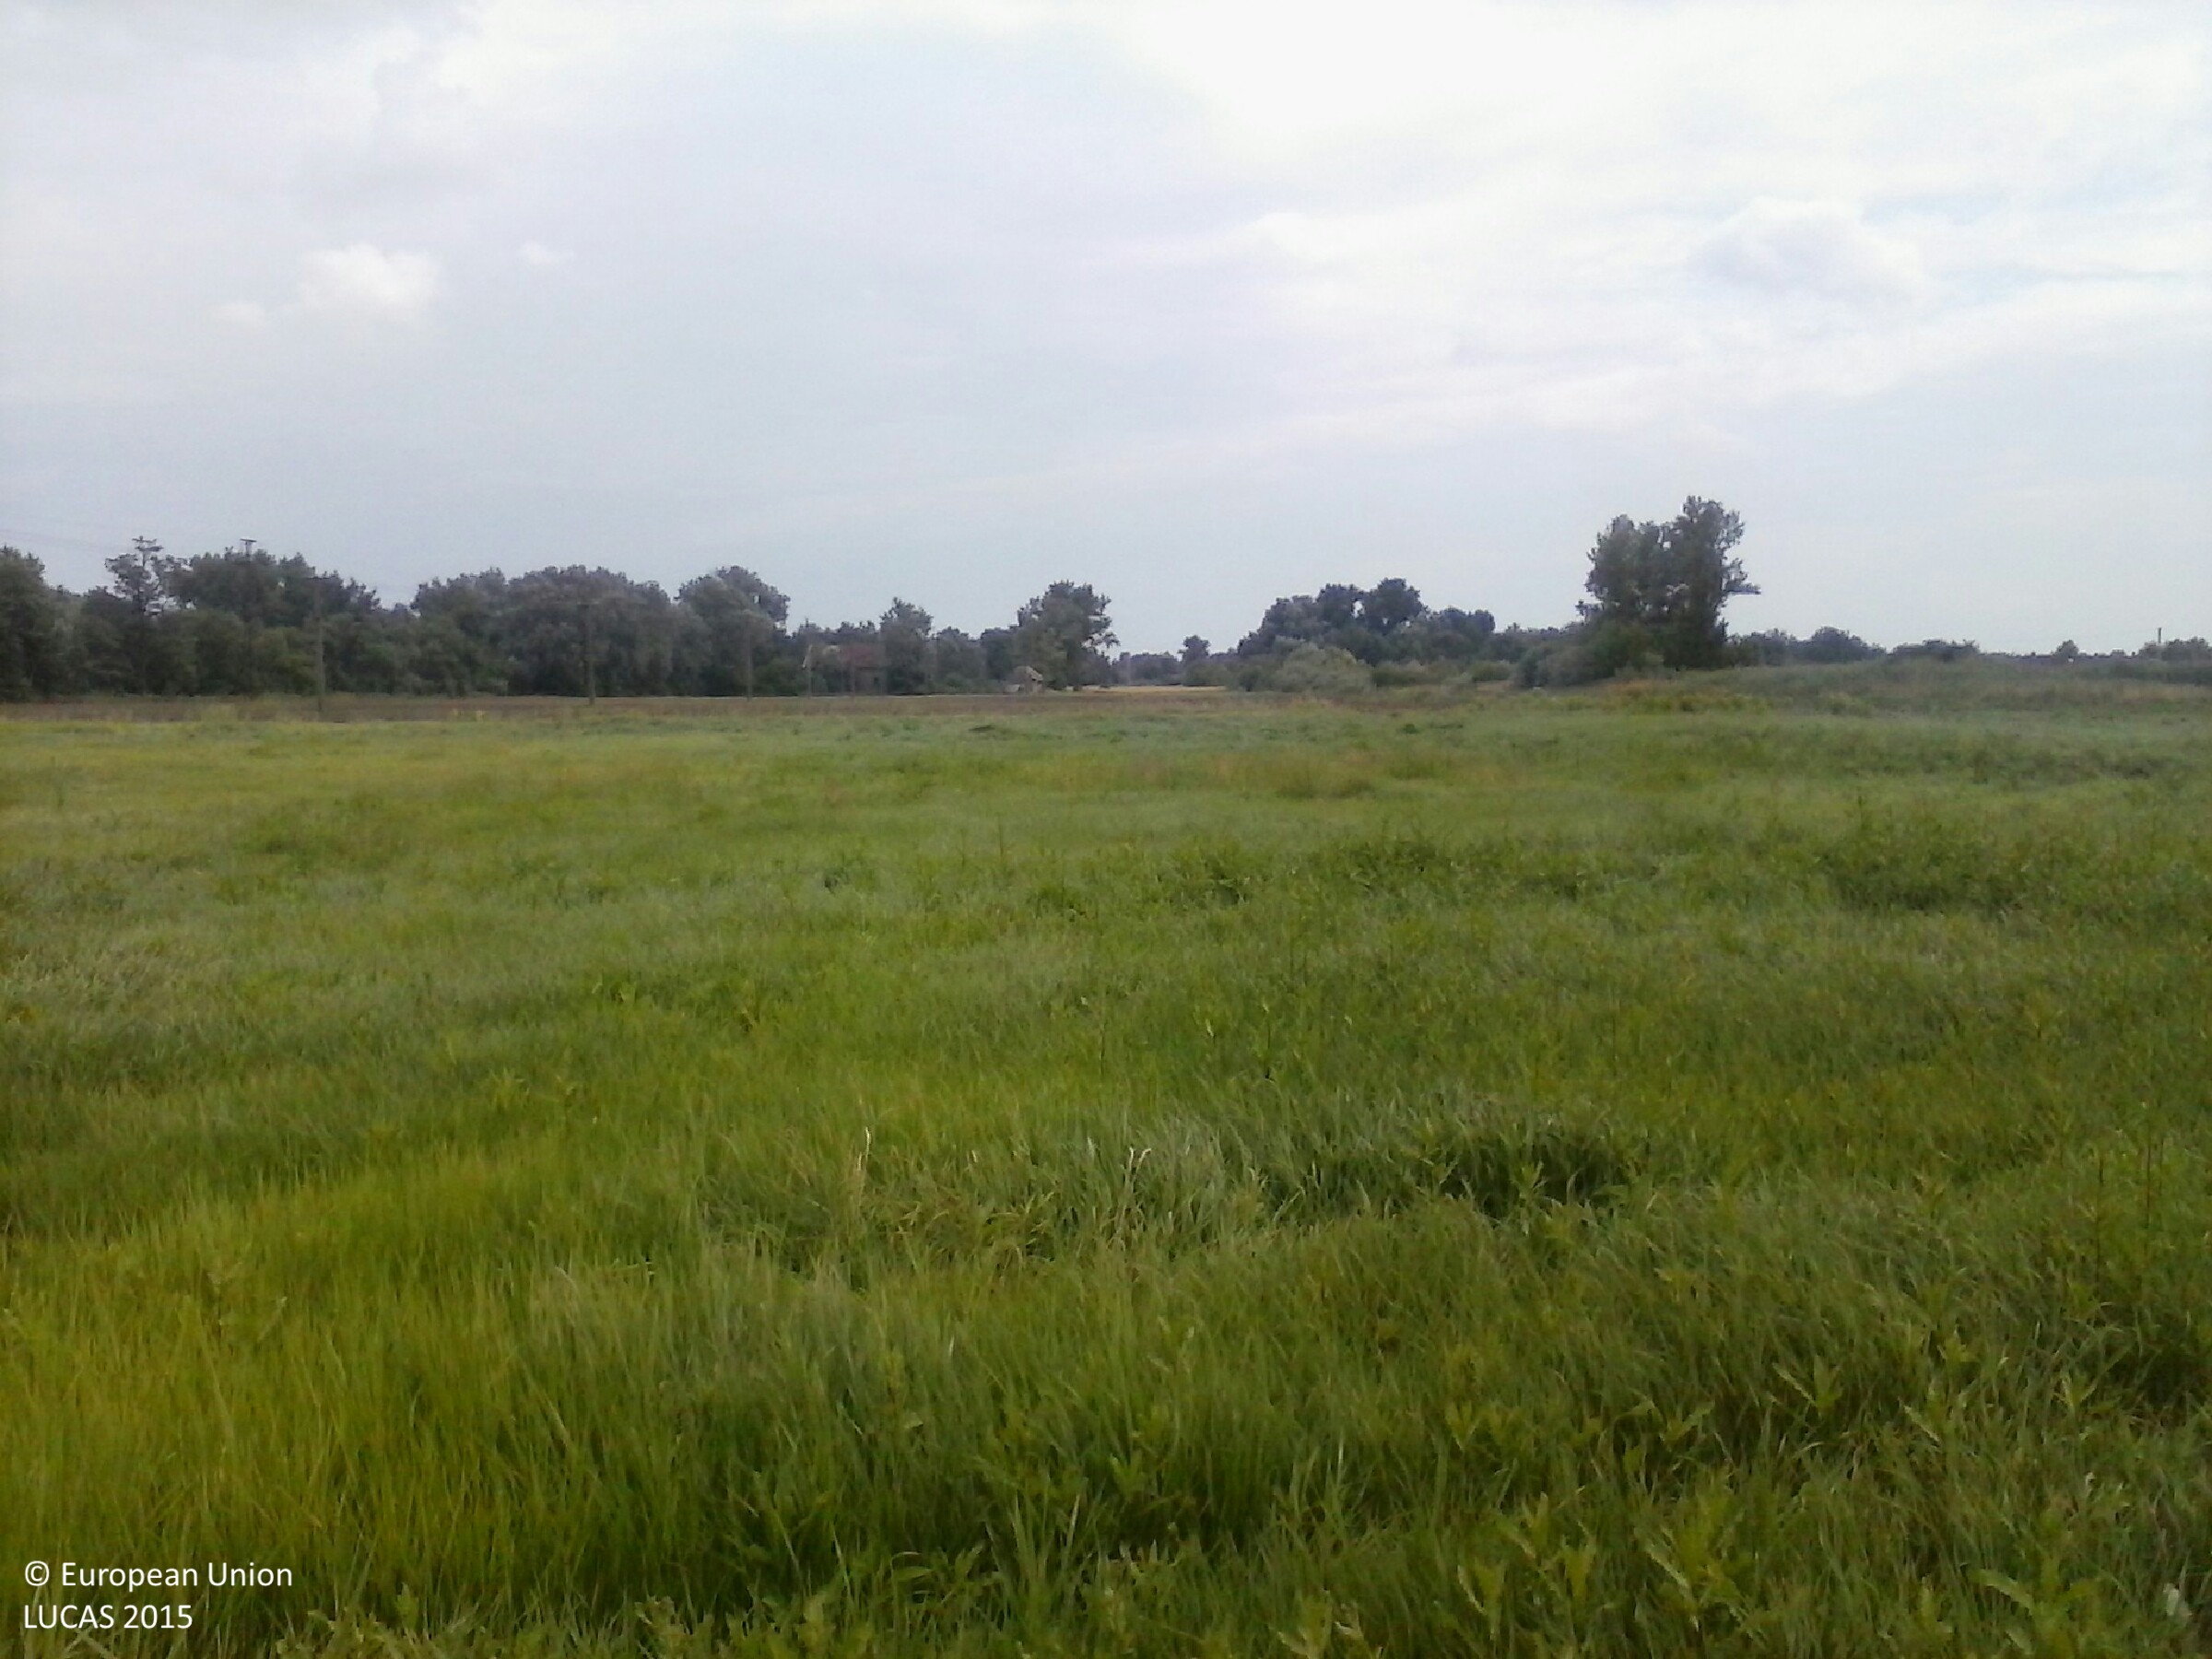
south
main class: Grassland
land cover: Grassland without tree/shrub cover
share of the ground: > 75 %
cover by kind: herbaceous plants 100 %
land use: Agriculture (excluding fallow land and kitchen gardens)
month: June
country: HU
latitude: 46.3672
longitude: 20.0435
